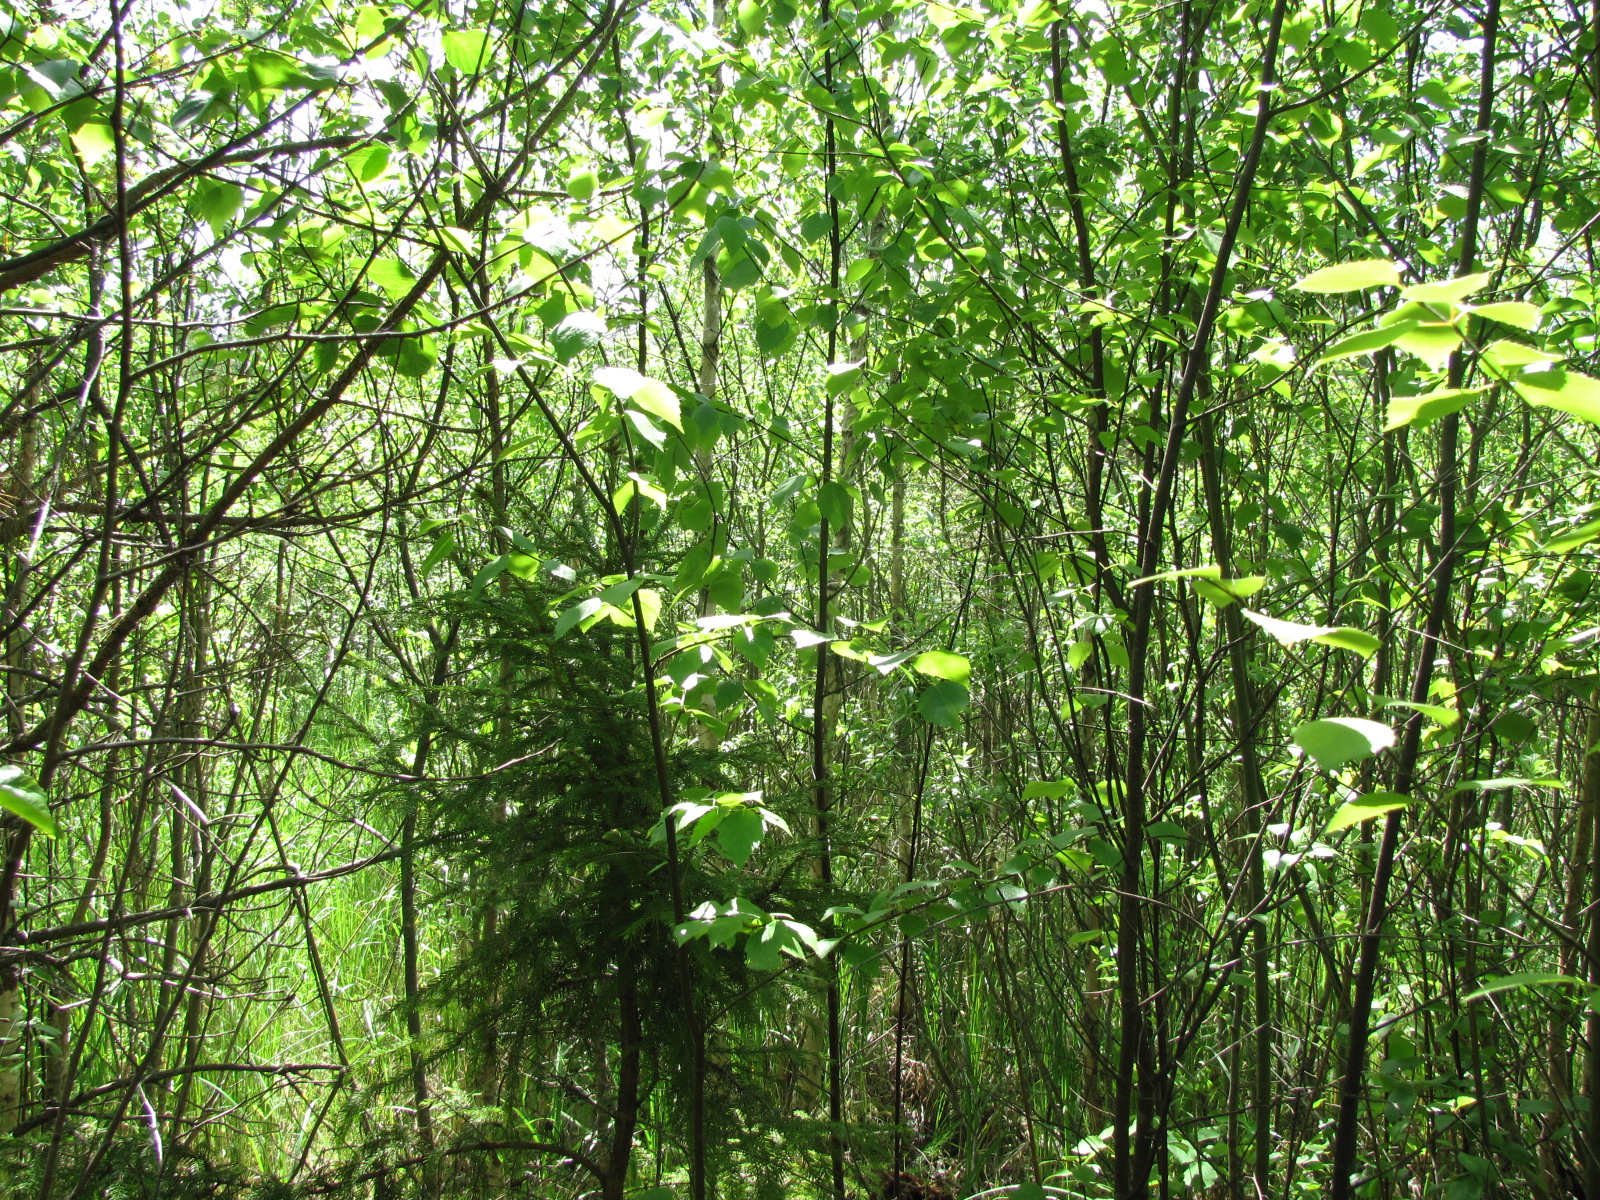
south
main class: Woodland
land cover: Other mixed woodland
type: hemiboreal forest and nemoral coniferous forest and mixed broadleaved-coniferous forest
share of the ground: > 75 %
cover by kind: broadleaved forest trees 65 %, coniferous forest trees 30 %, lichens and mosses 5 %
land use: Forestry
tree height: < 5 m
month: June
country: LV
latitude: 56.9179
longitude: 24.4665
